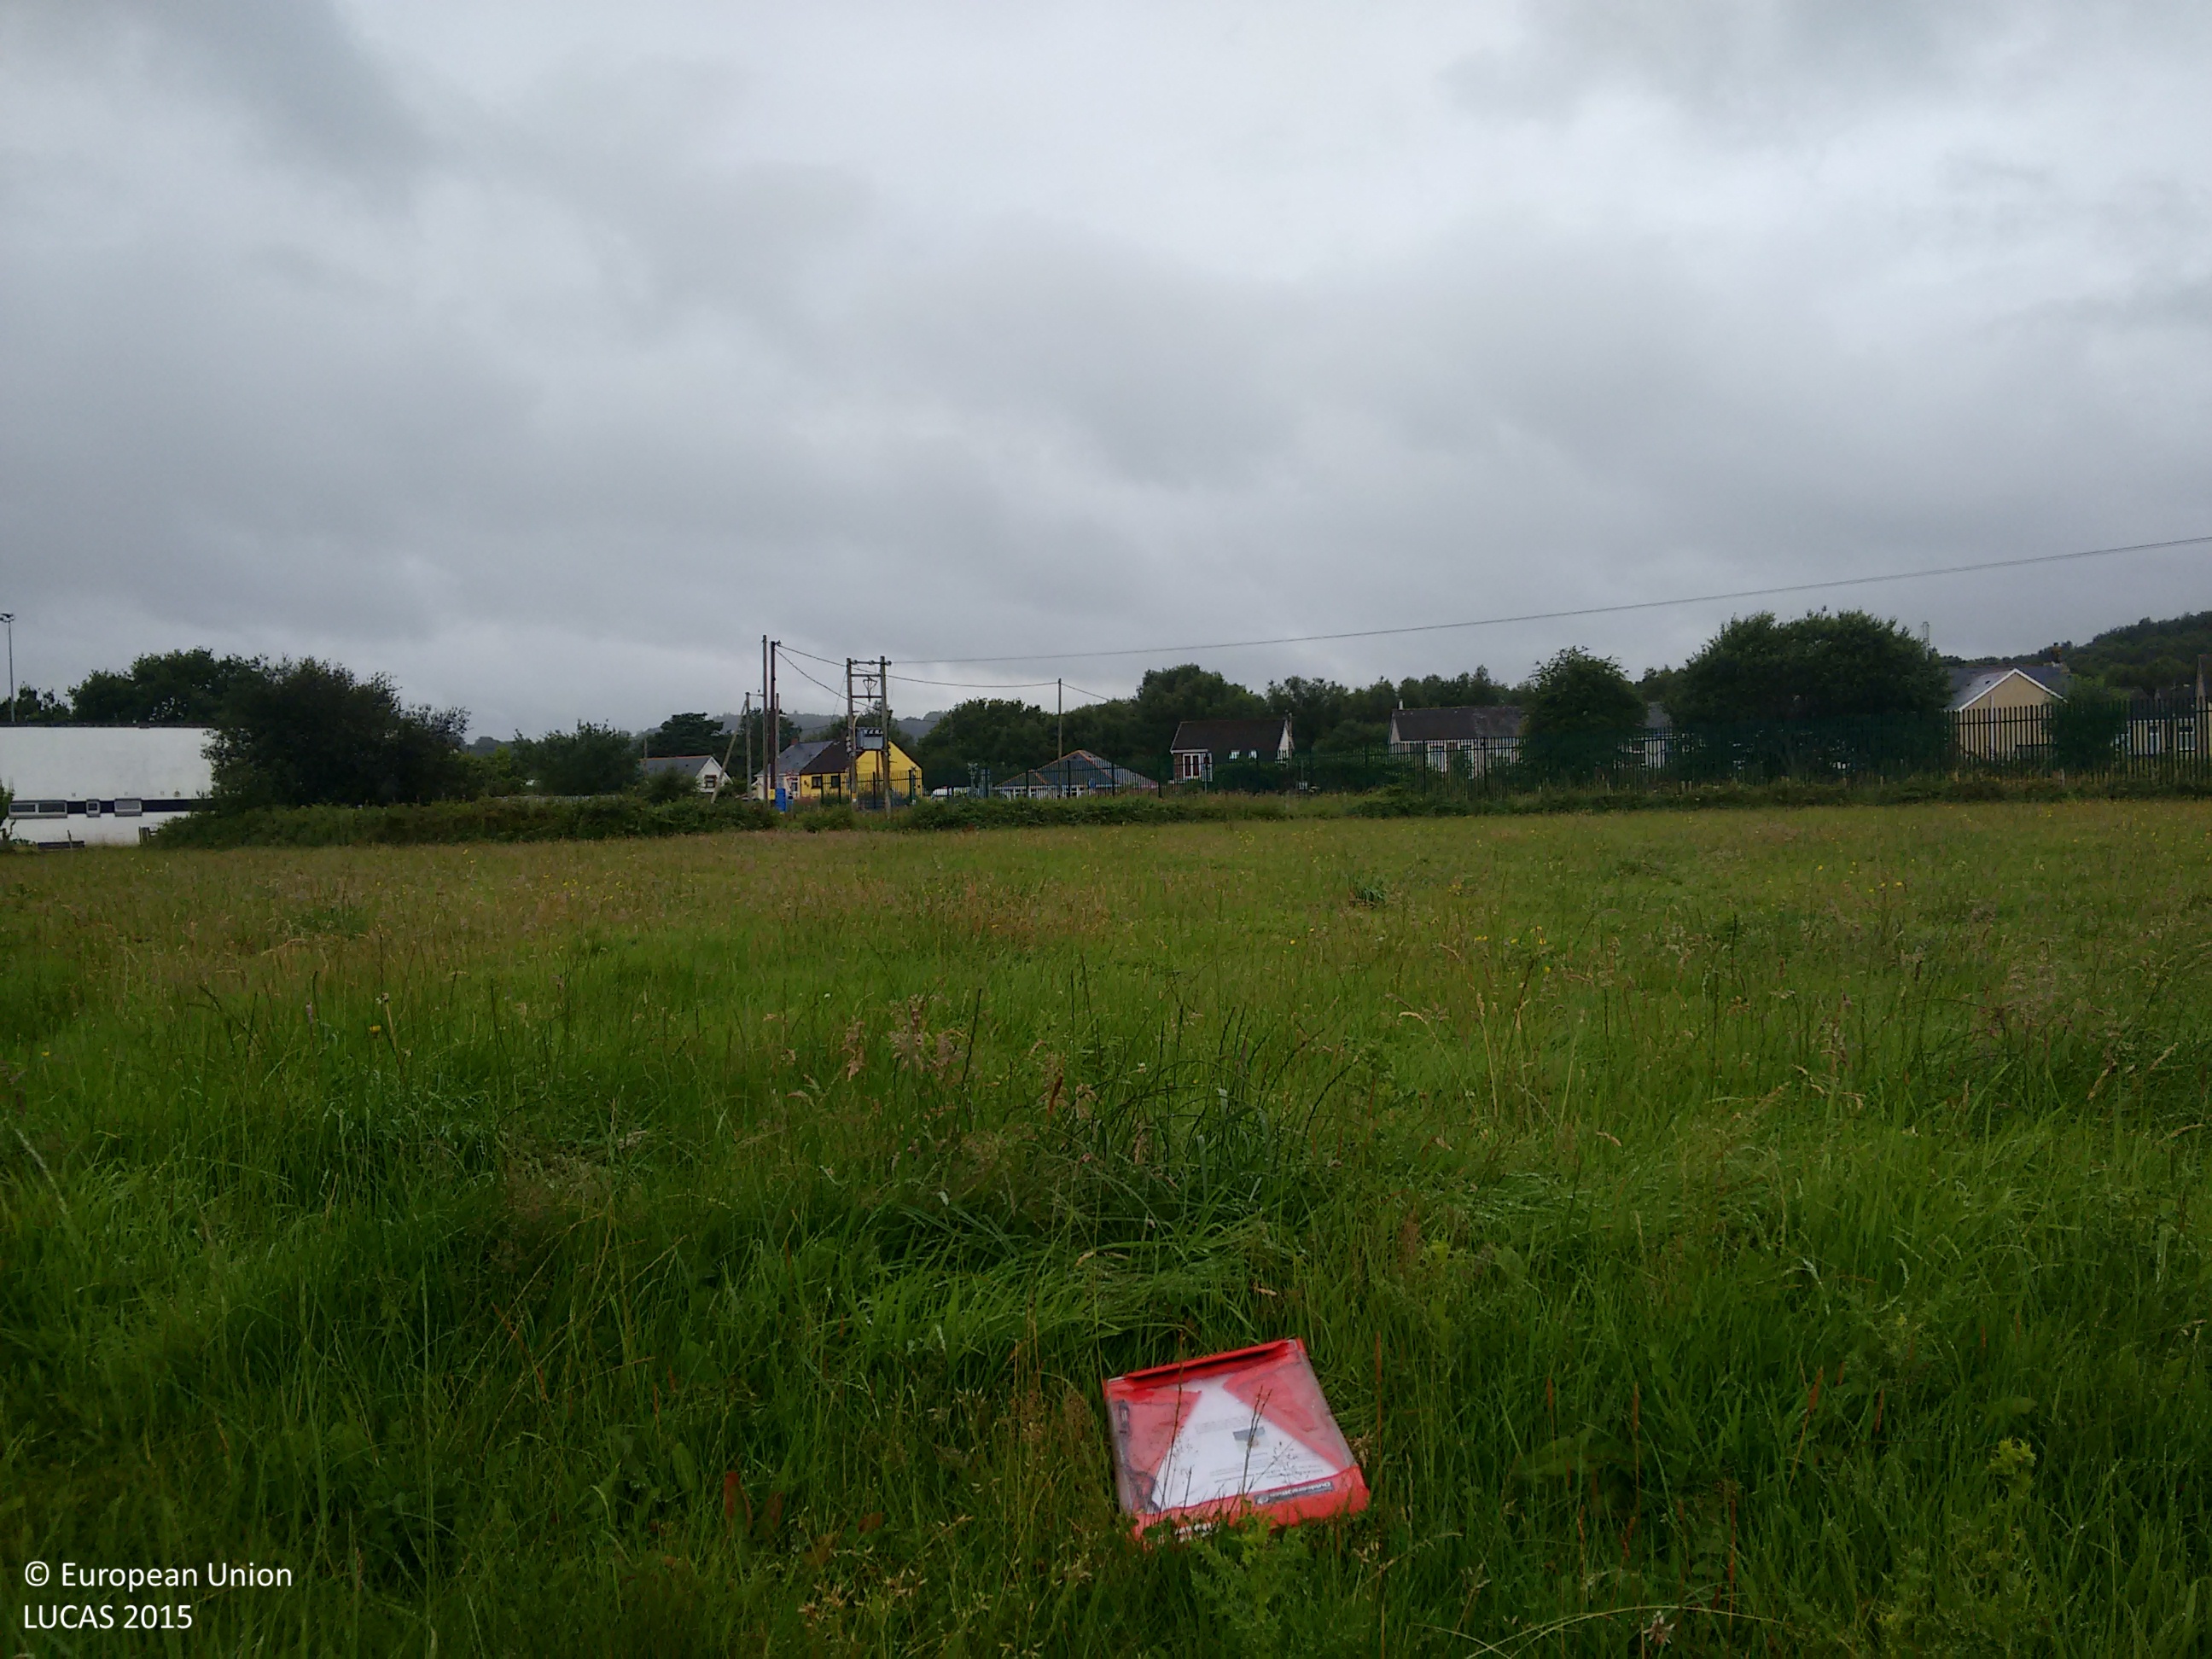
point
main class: Grassland
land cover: Grassland without tree/shrub cover
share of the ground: > 75 %
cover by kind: herbaceous plants 100 %
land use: Agriculture (excluding fallow land and kitchen gardens)
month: July
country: GB
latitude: 51.7803
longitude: -3.9950
